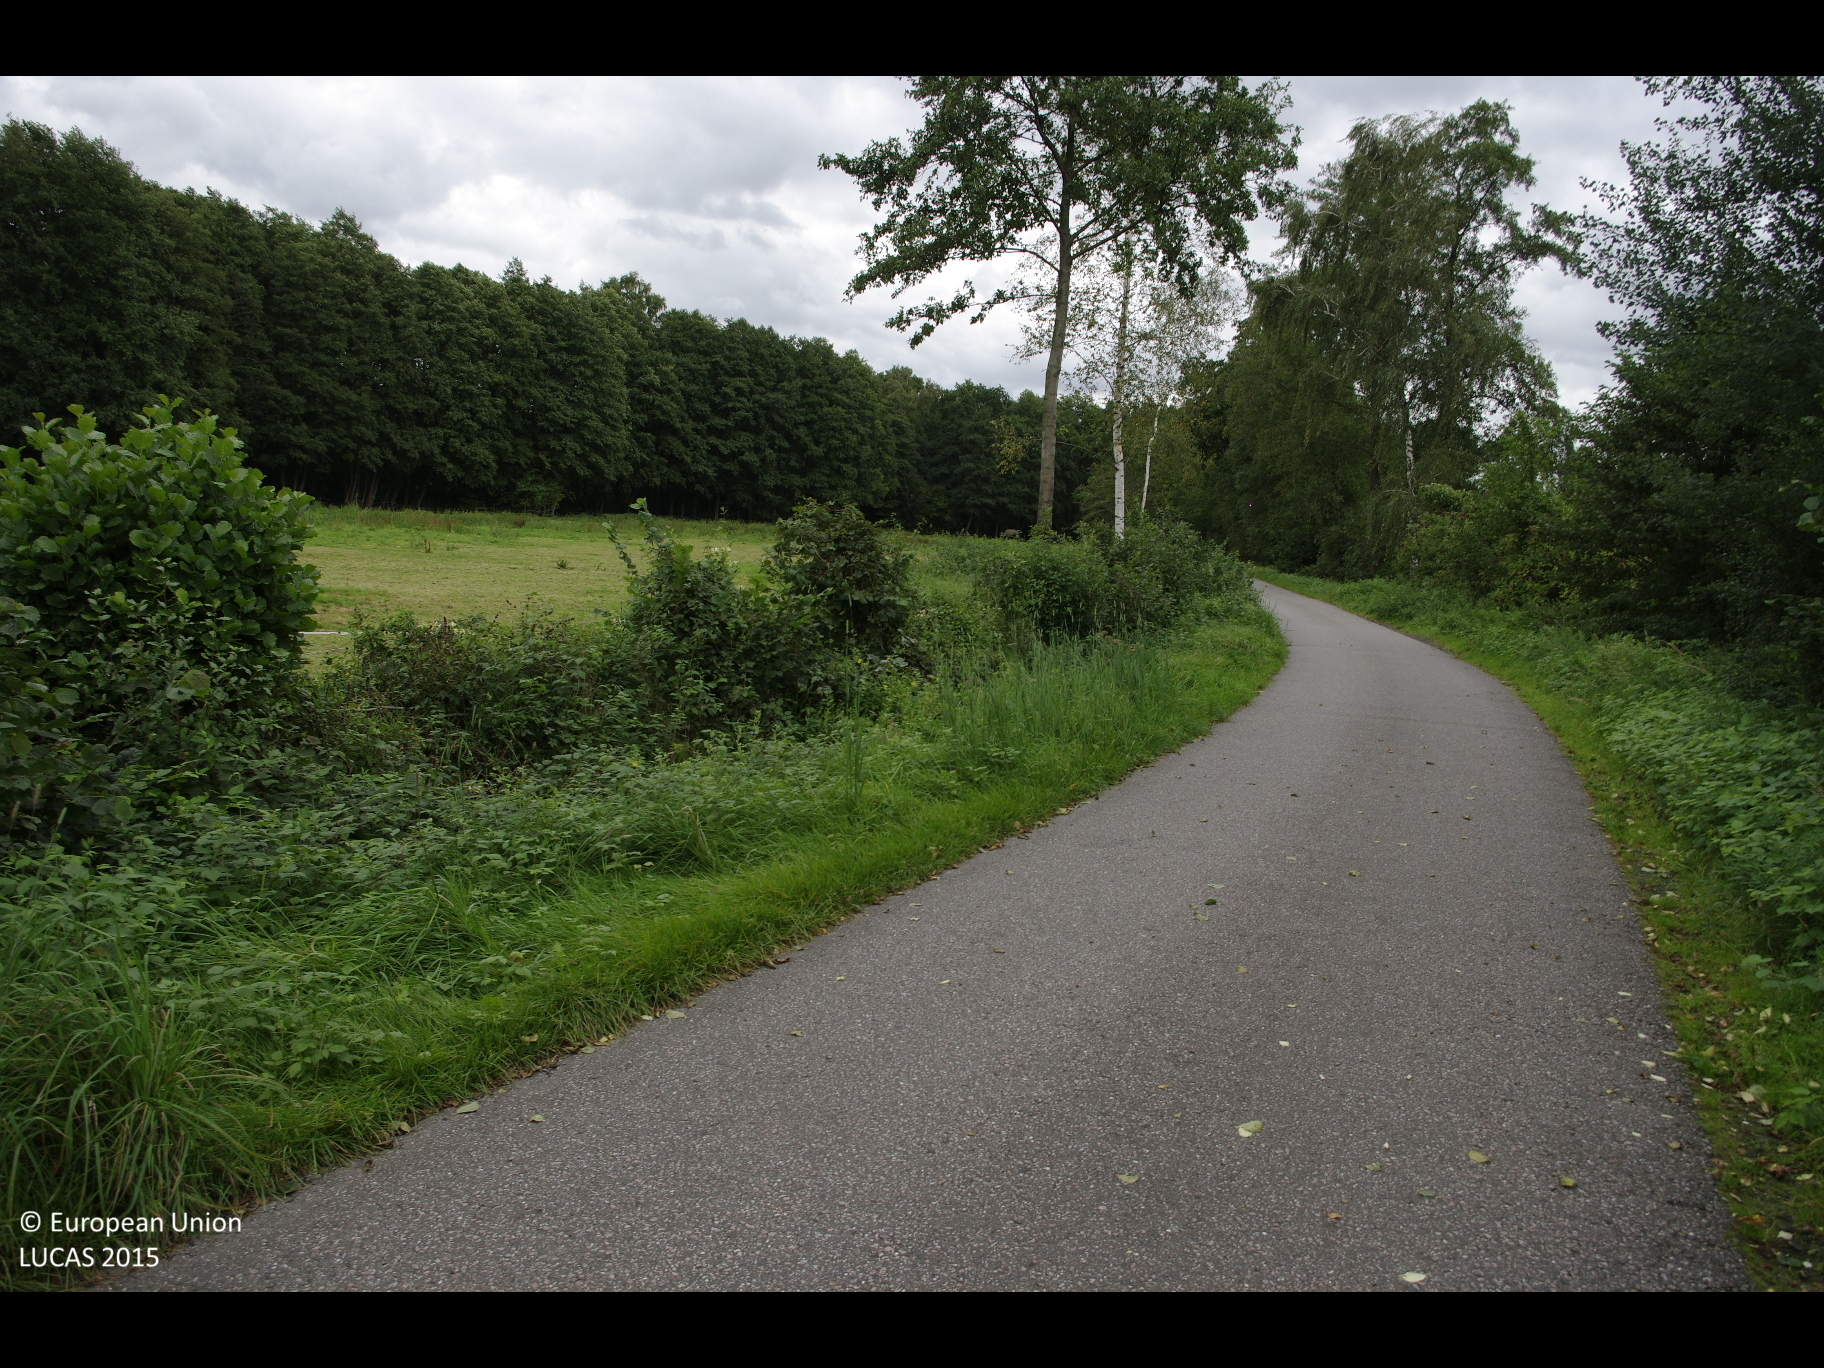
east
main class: Cropland
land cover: Potatoes
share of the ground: 50 - 75 %
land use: Agriculture (excluding fallow land and kitchen gardens)
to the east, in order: Potatoes; Fences; Grassland without tree/shrub cover; Fences; Broadleaved woodland; Paved roads, cycling and walking lanes; Abandoned hedges; Fences; Grassland without tree/shrub cover; Fences; Ditches and canals; Broadleaved woodland
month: September
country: DE
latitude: 53.5992
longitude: 10.3172
